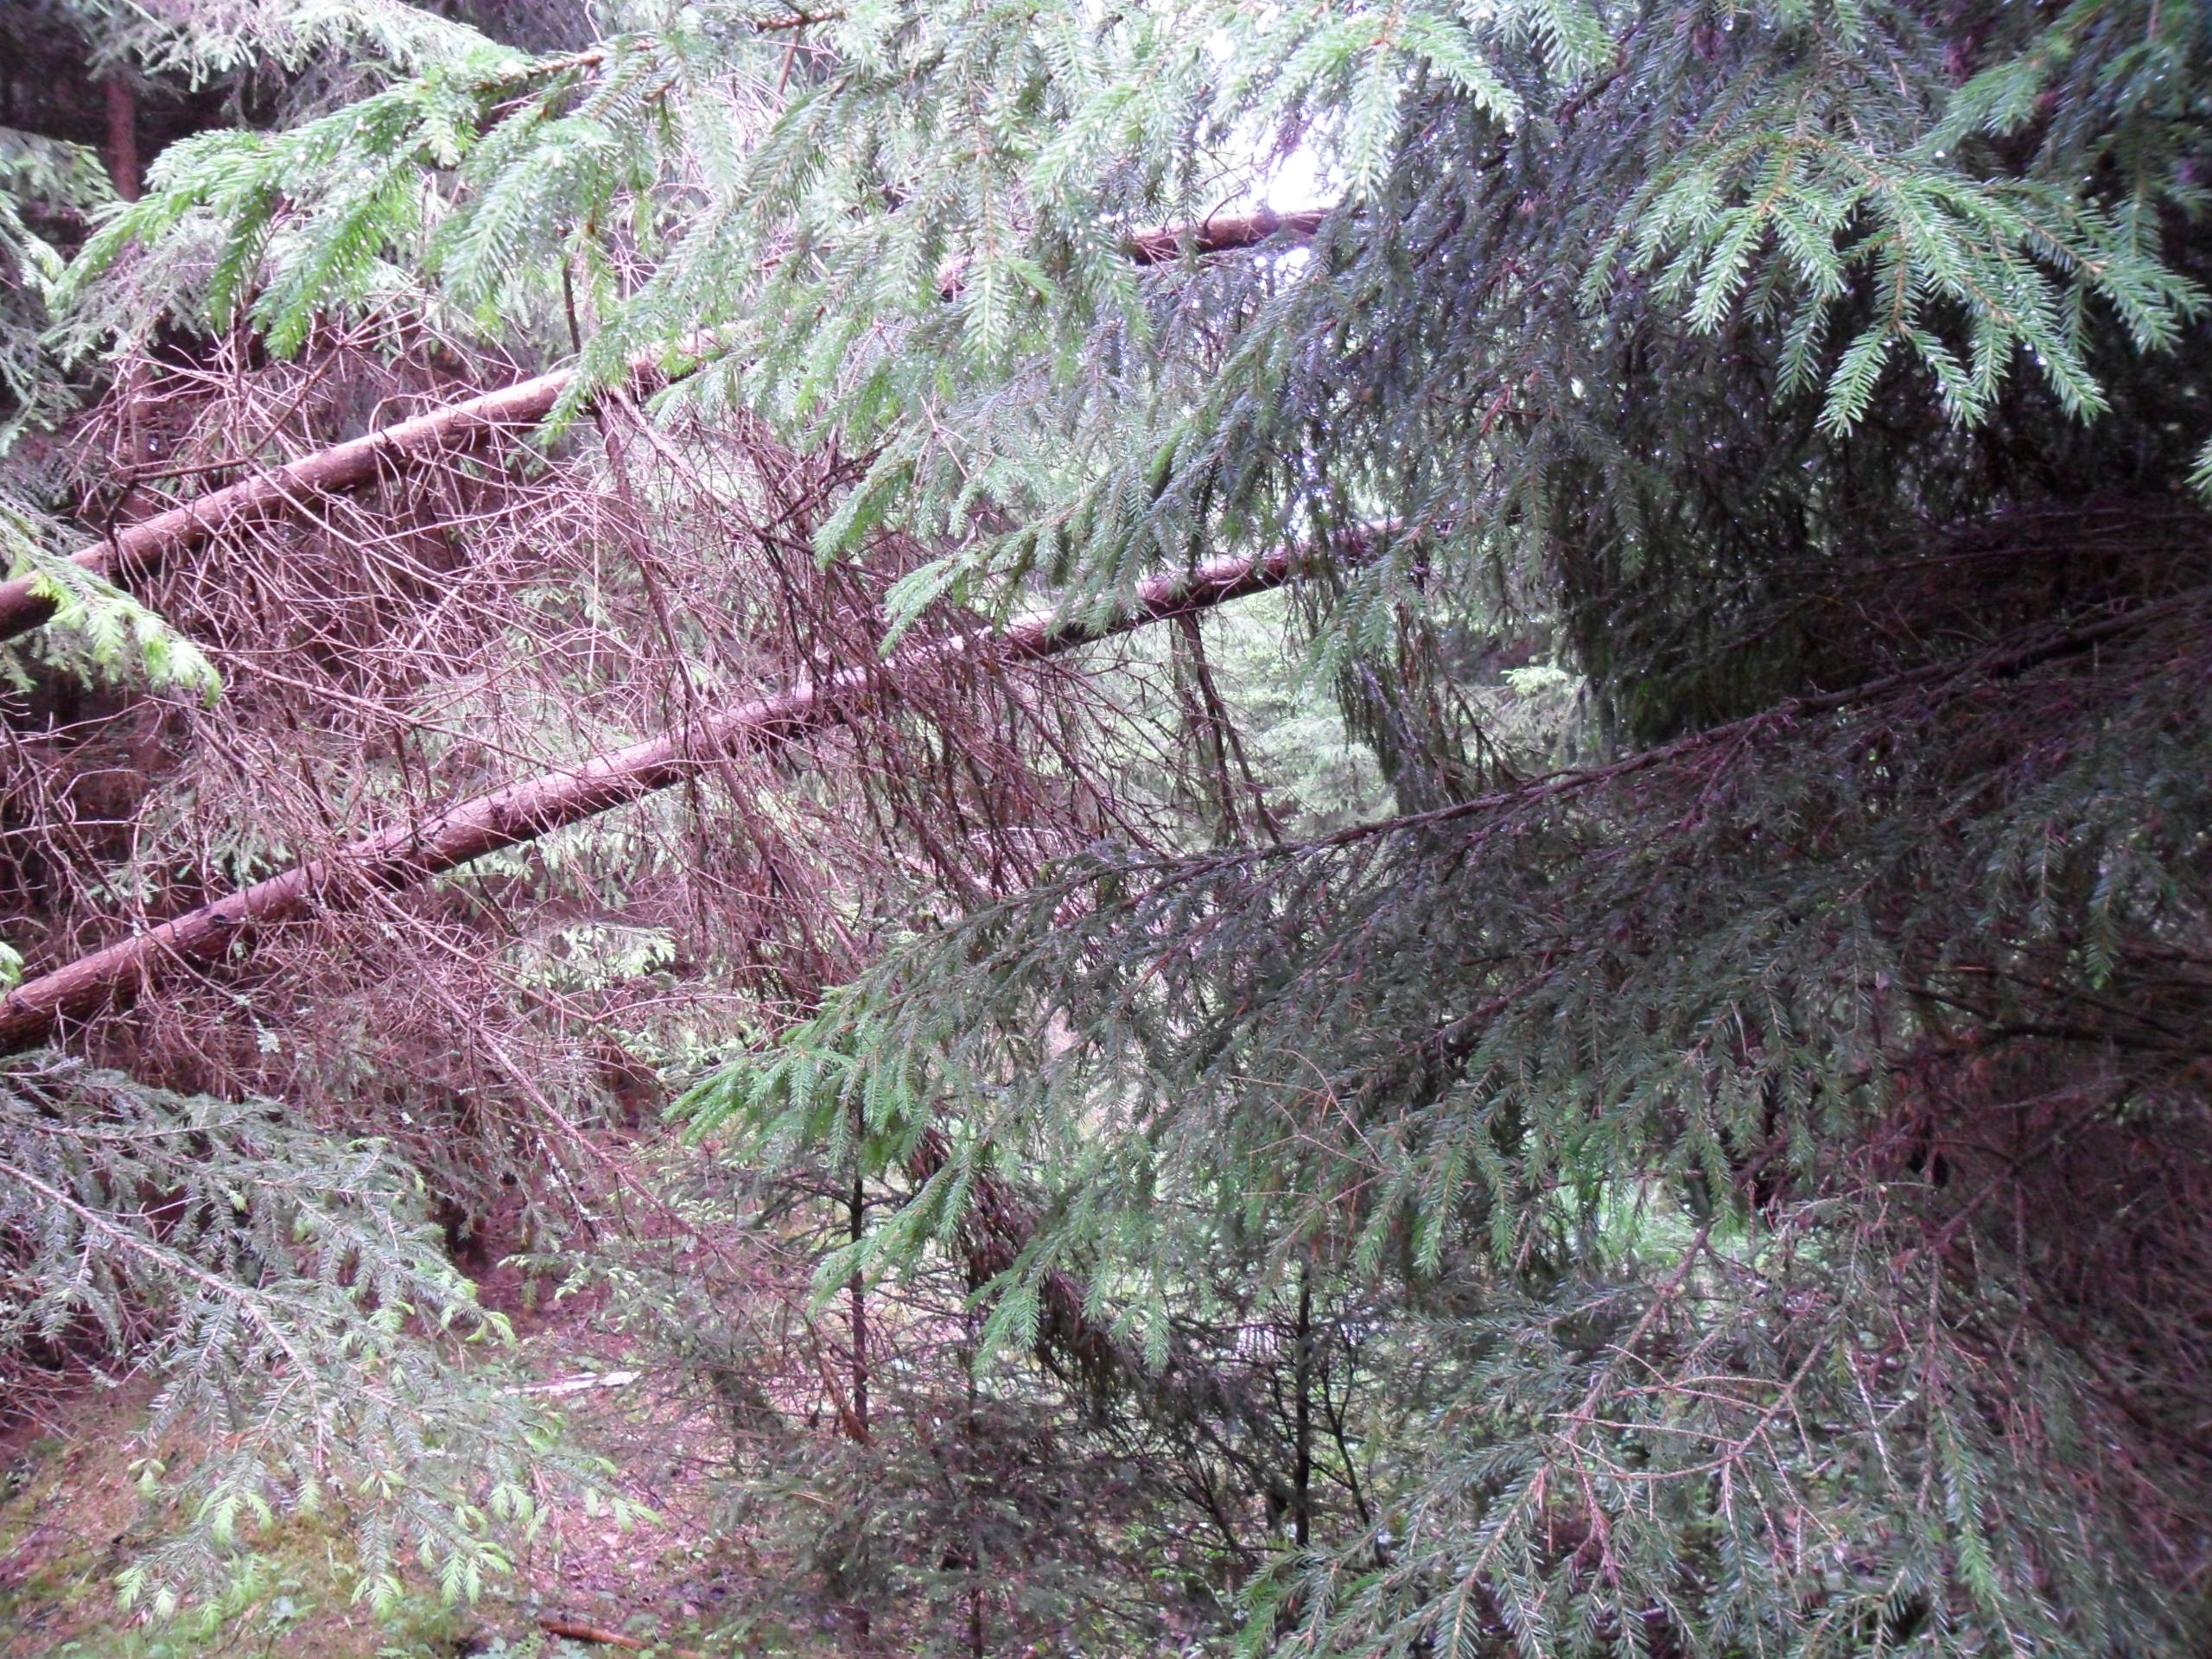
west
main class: Woodland
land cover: Spruce dominated coniferous woodland
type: hemiboreal forest and nemoral coniferous forest and mixed broadleaved-coniferous forest
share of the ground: > 75 %
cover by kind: coniferous forest trees 80 %, herbaceous plants 10 %, lichens and mosses 10 %
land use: Forestry
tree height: > 5 m
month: June
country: LV
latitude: 57.3814
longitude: 22.0725
